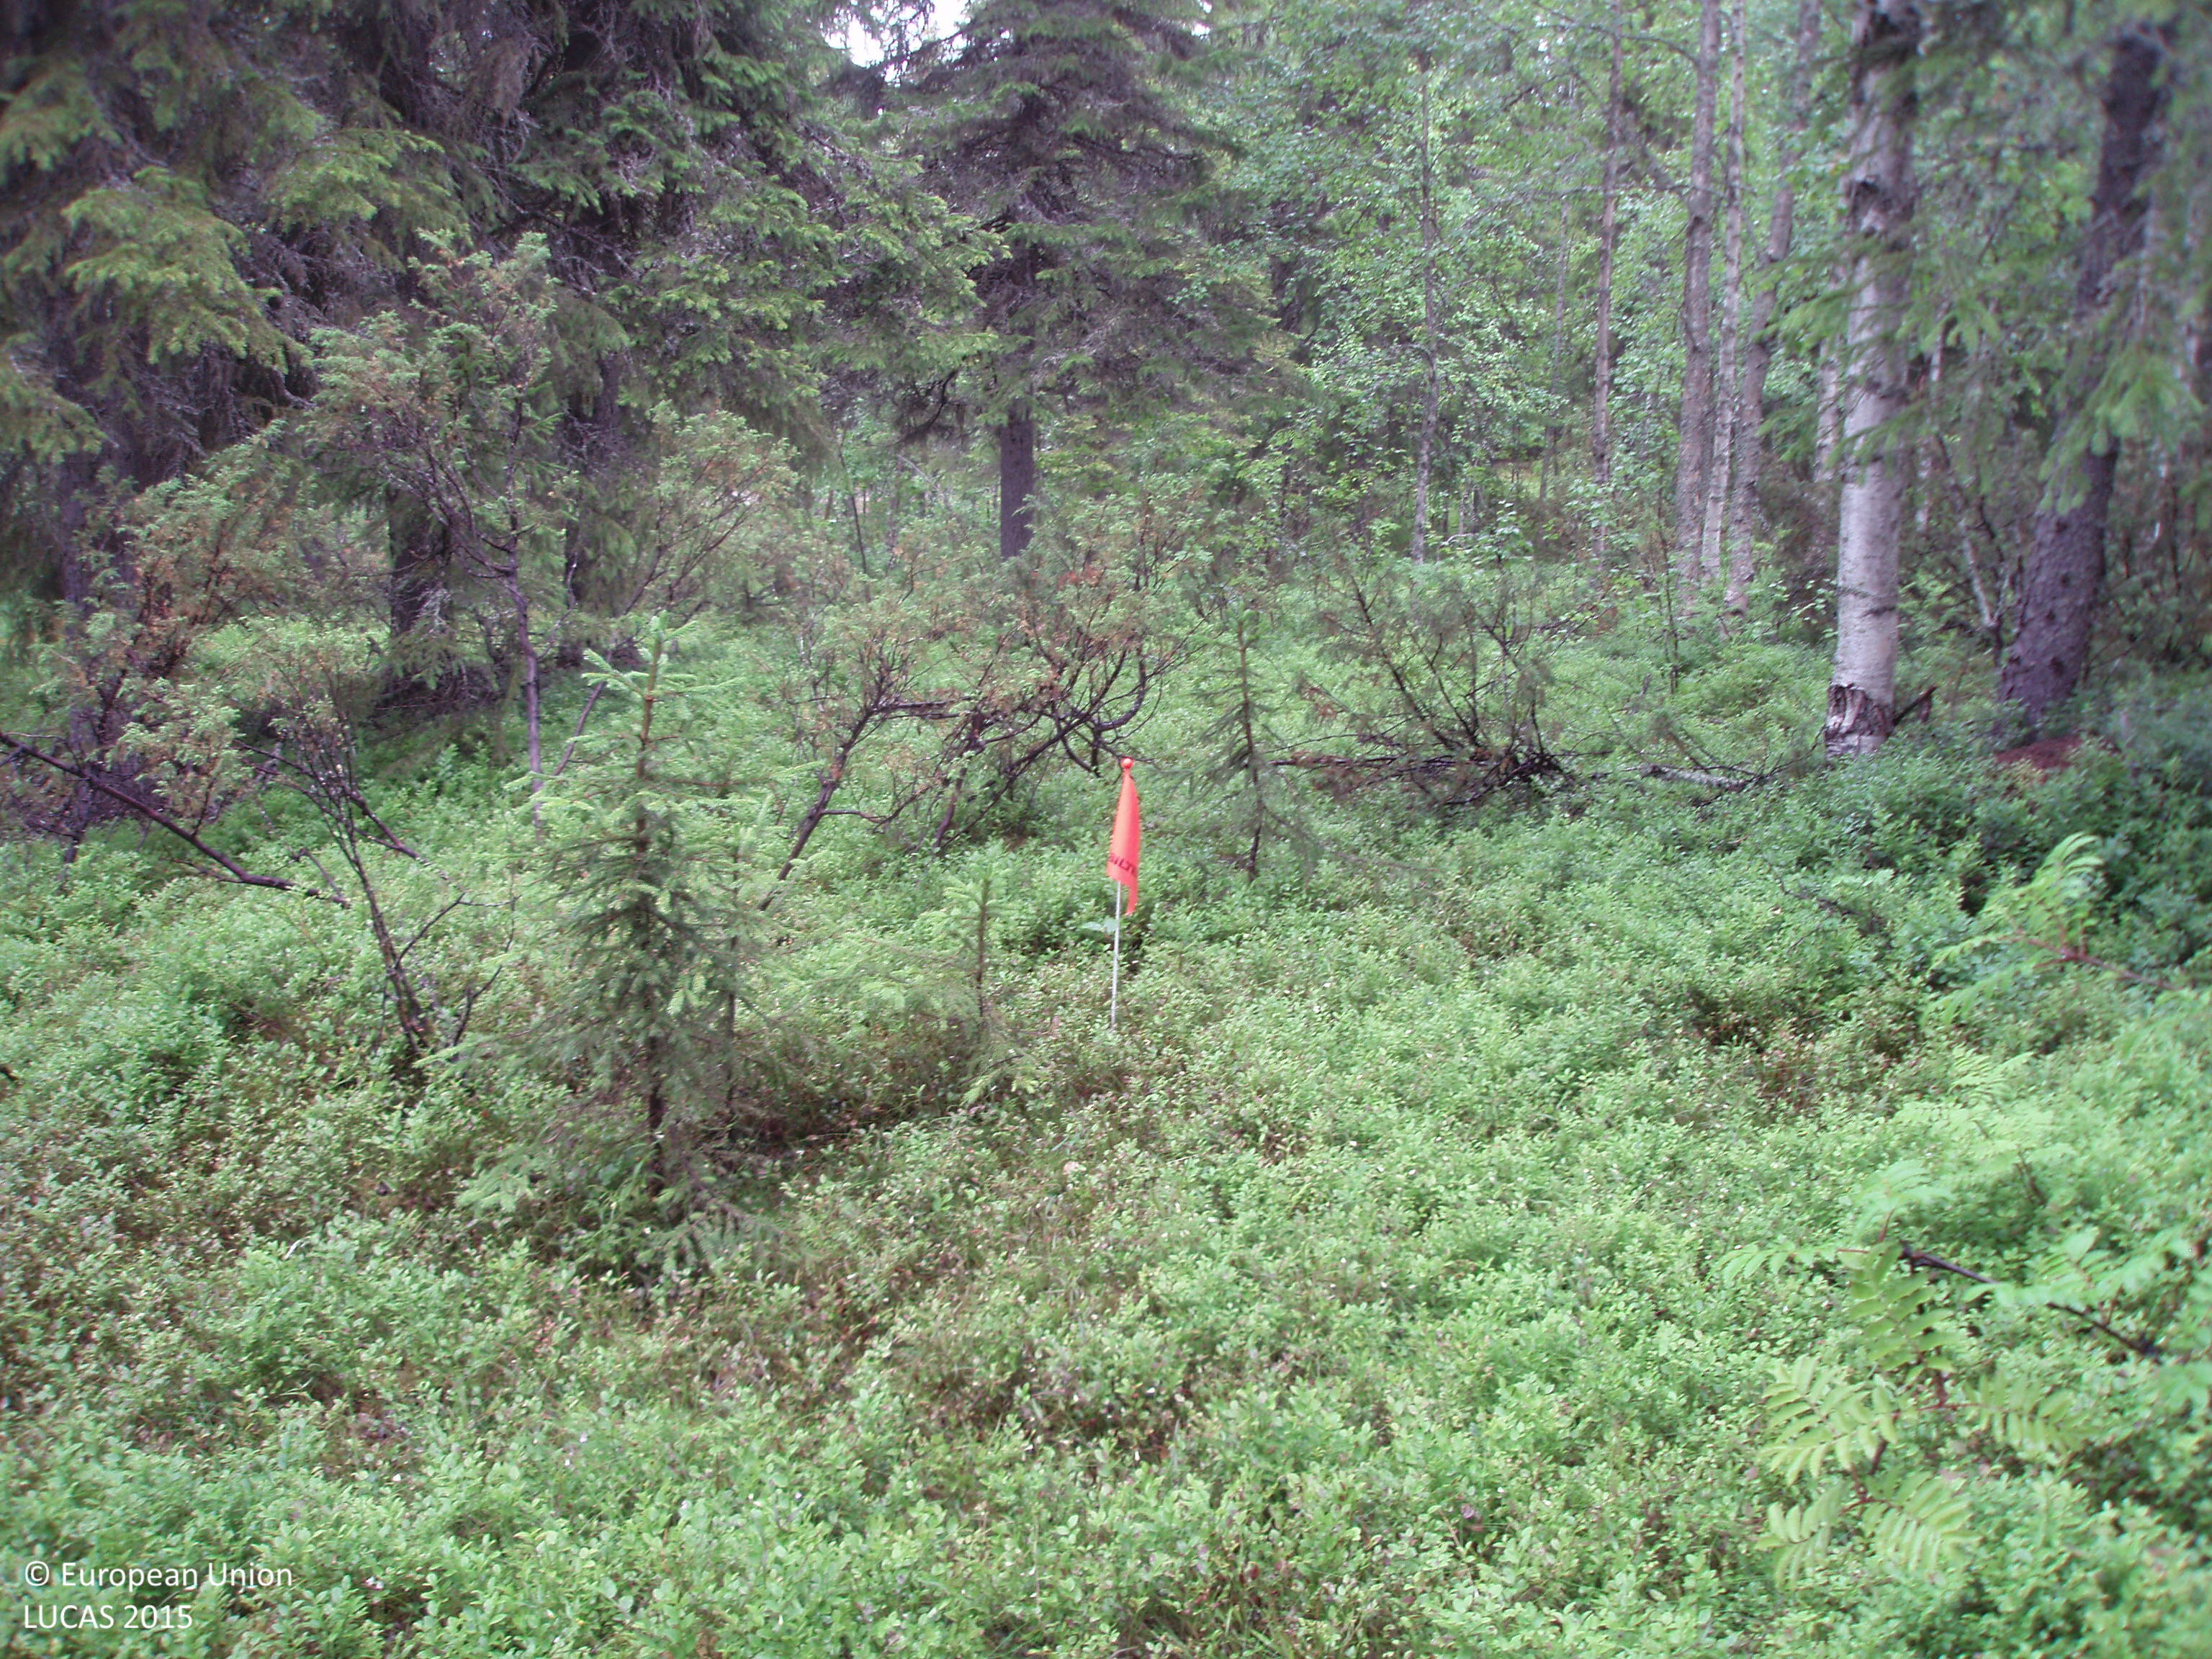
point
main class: Woodland
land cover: Spruce dominated mixed woodland
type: boreal forest
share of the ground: > 75 %
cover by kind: coniferous forest trees 40 %, broadleaved forest trees 35 %, shrubs 25 %
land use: Forestry
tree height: > 5 m
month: August
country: FI
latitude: 65.6310
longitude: 27.6603
